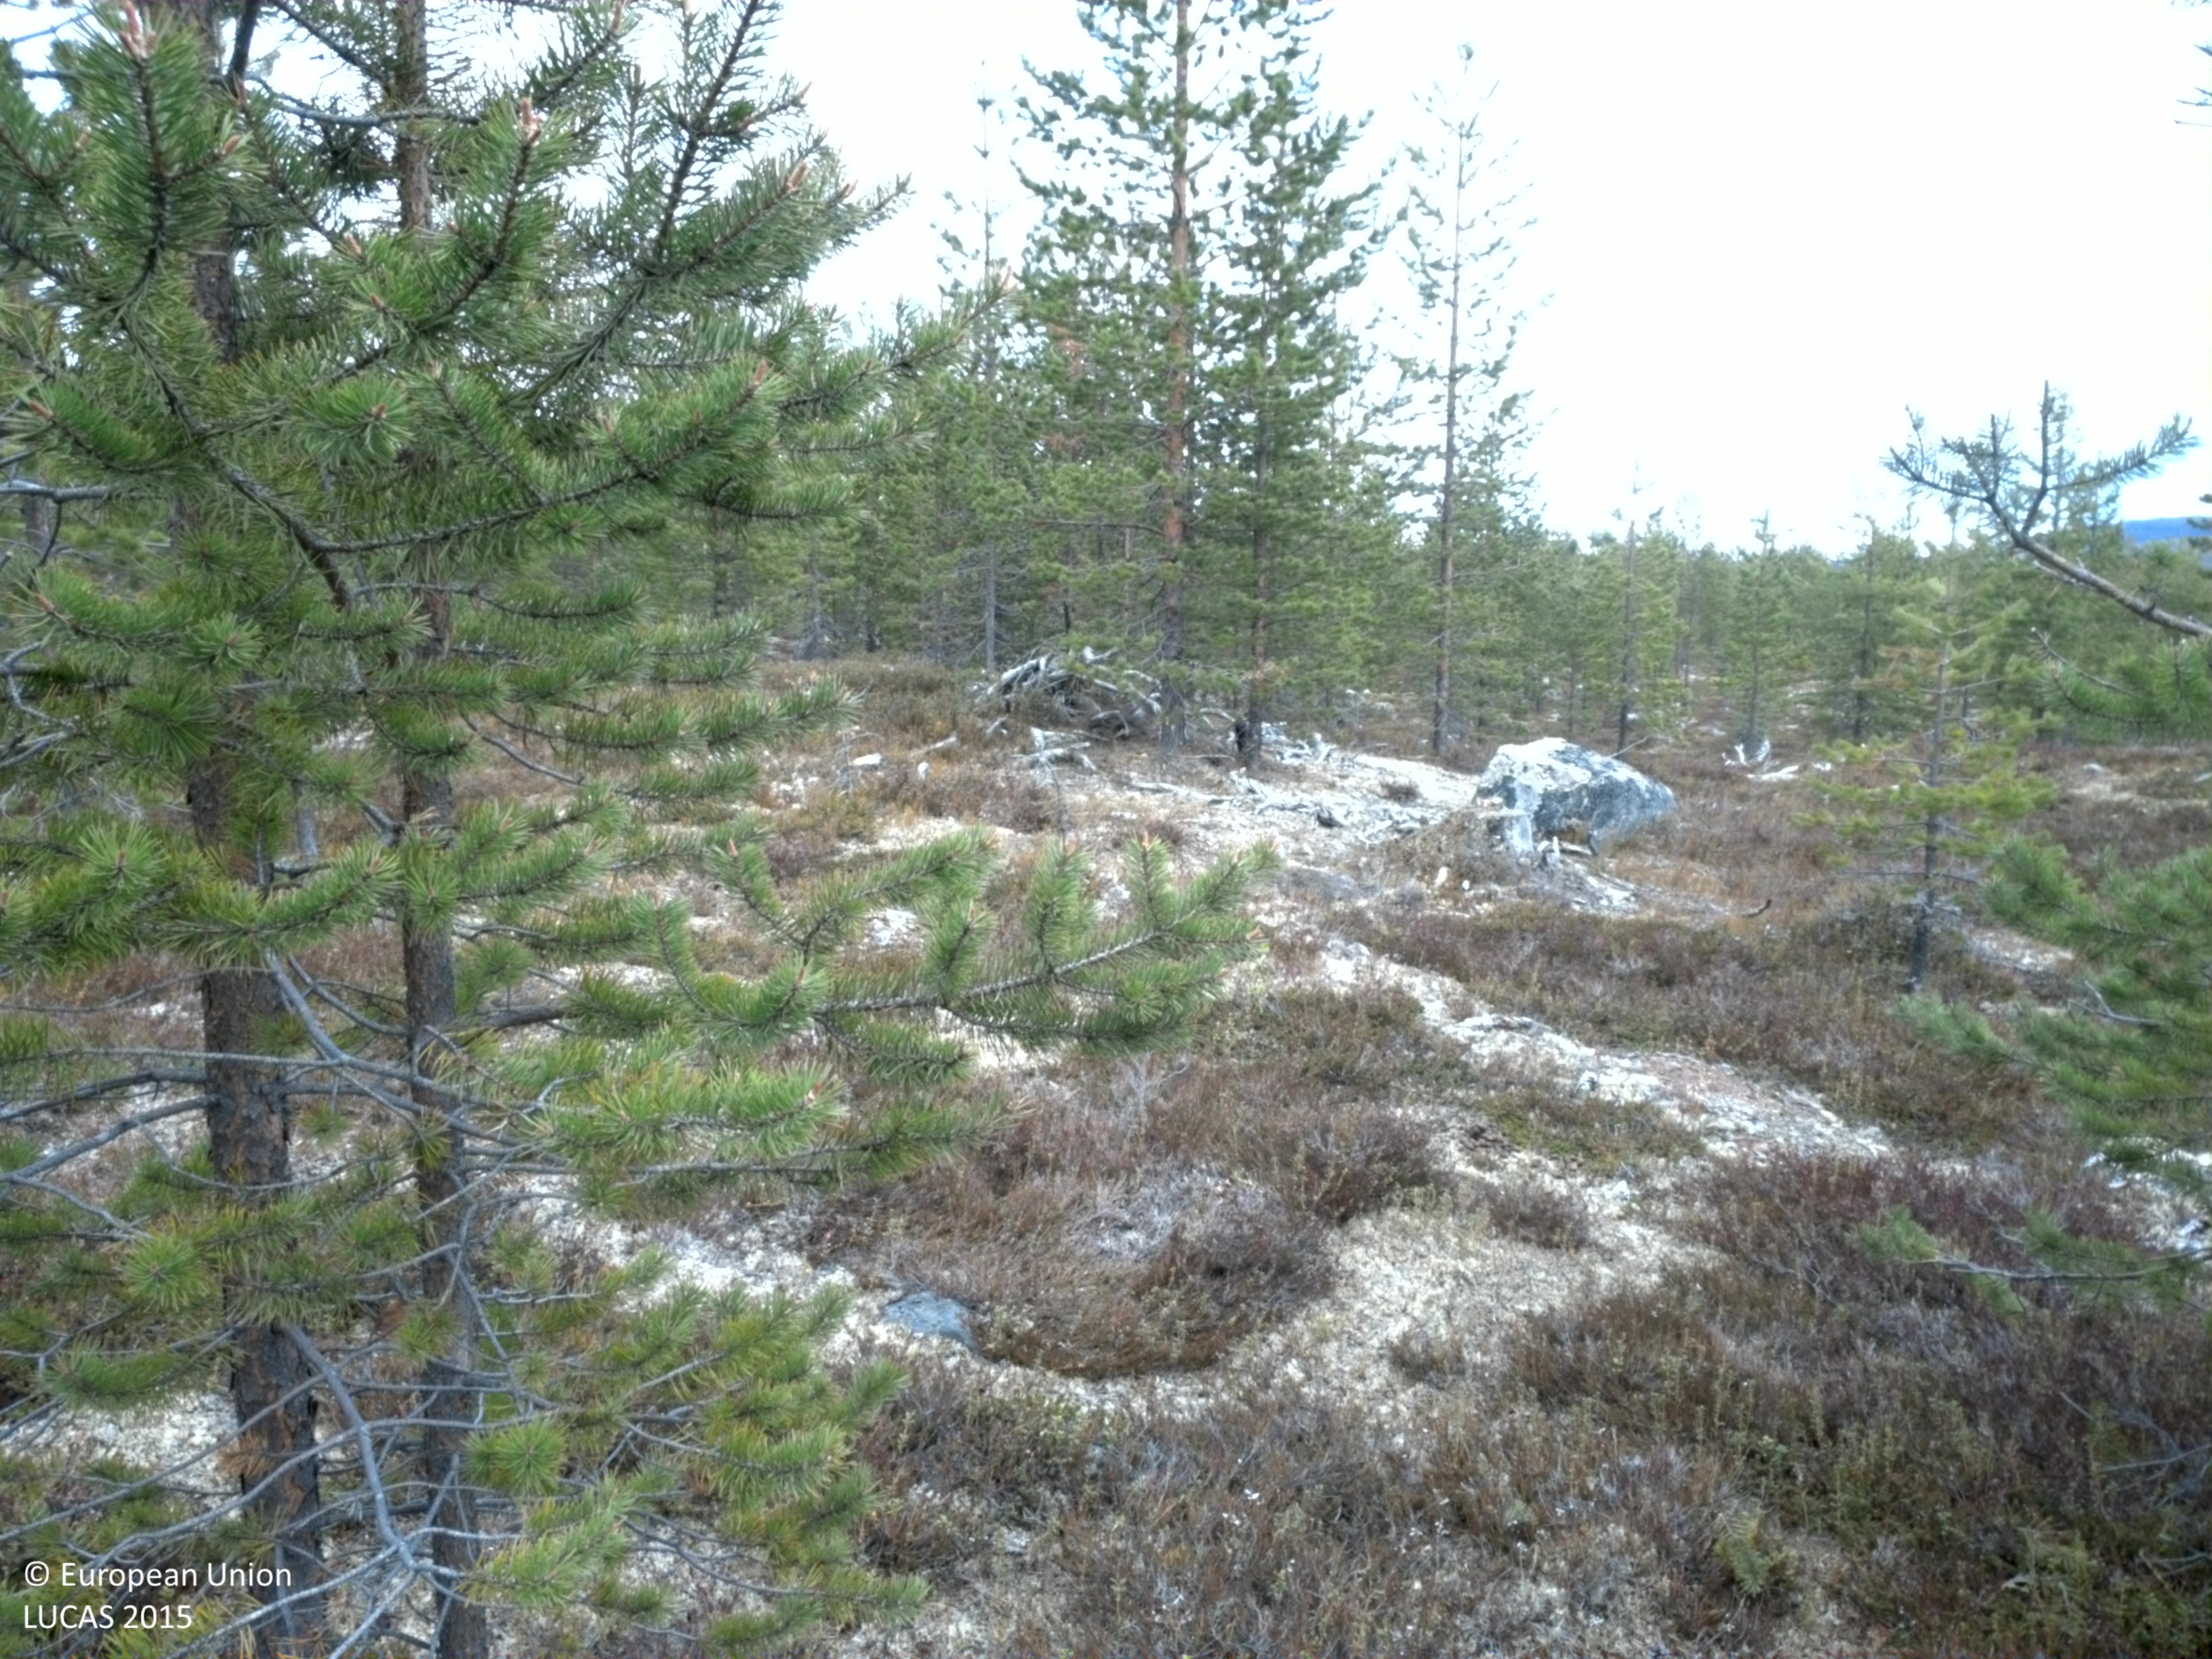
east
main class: Woodland
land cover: Pine dominated coniferous woodland
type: boreal forest
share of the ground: 25 - 50 %
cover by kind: shrubs 50 %, coniferous forest trees 35 %, lichens and mosses 15 %
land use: Forestry
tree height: < 5 m
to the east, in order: Pine dominated coniferous woodland
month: June
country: SE
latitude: 66.2278
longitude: 18.8244
